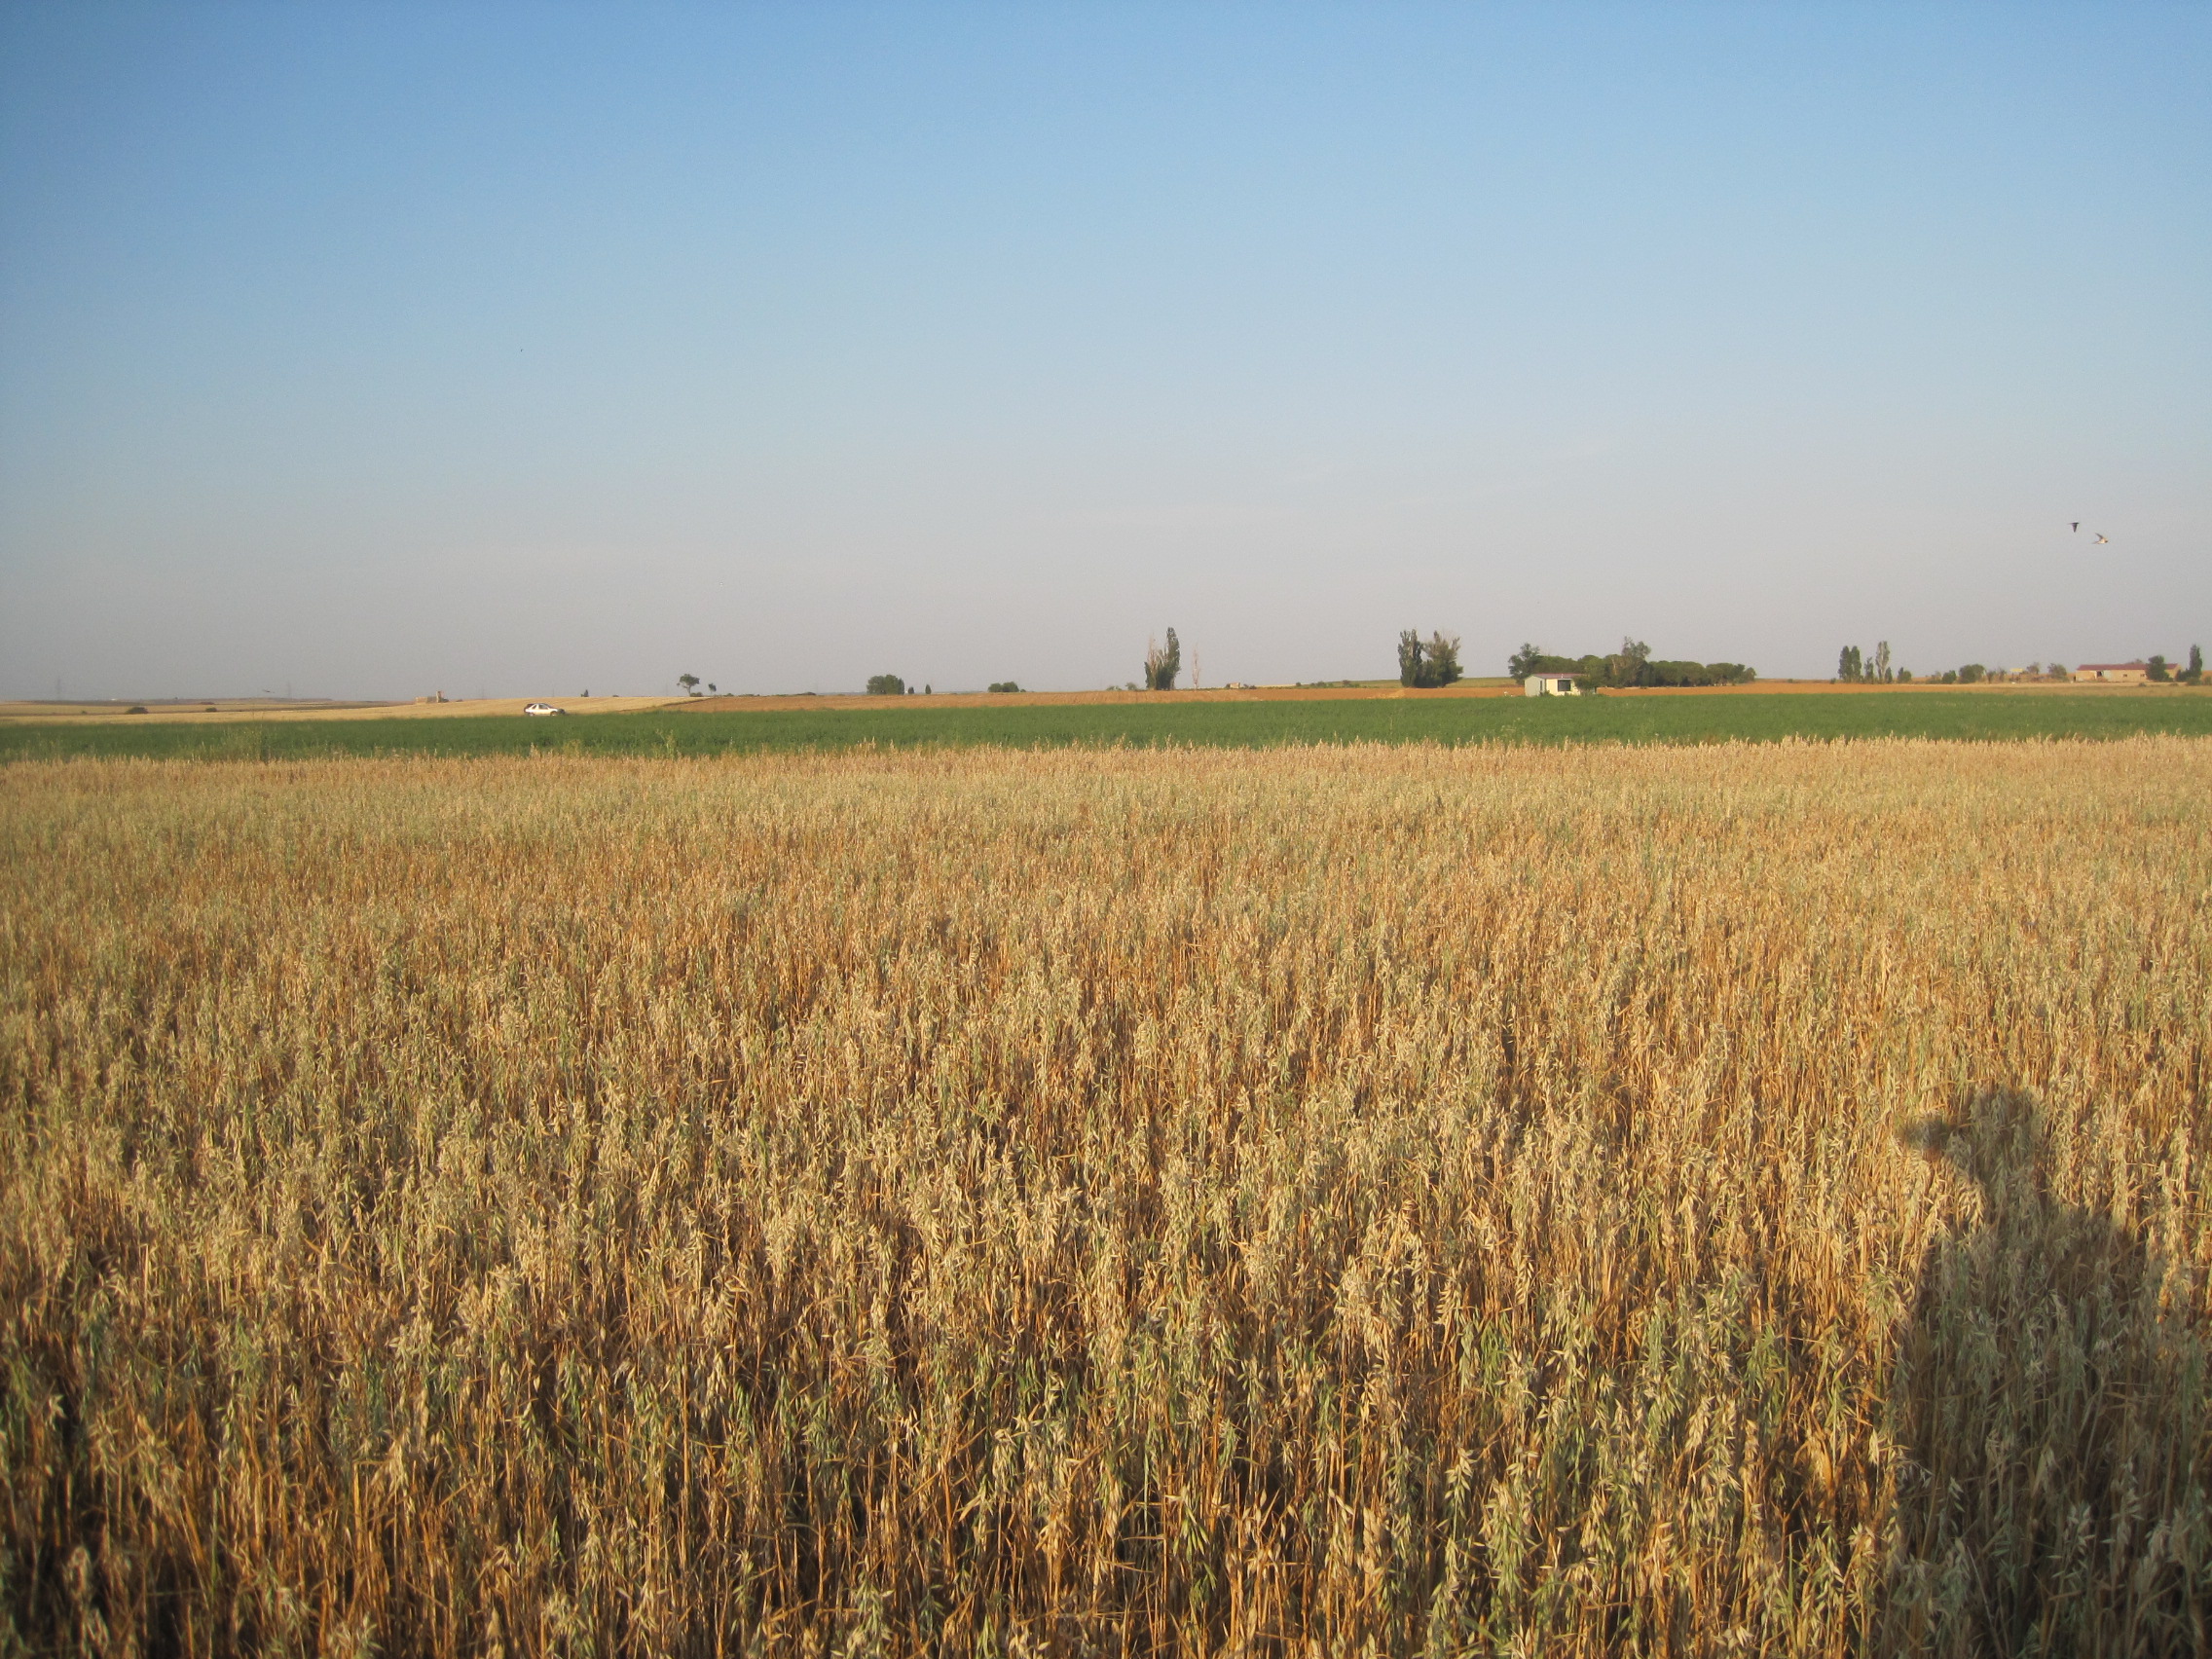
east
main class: Cropland
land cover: Oats
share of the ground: > 75 %
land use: Agriculture (excluding fallow land and kitchen gardens)
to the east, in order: Oats; Grass margins; Lucerne; Spontaneously vegetated surfaces; Tracks; Grass margins
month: July
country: ES
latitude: 41.8696
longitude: -5.1765
